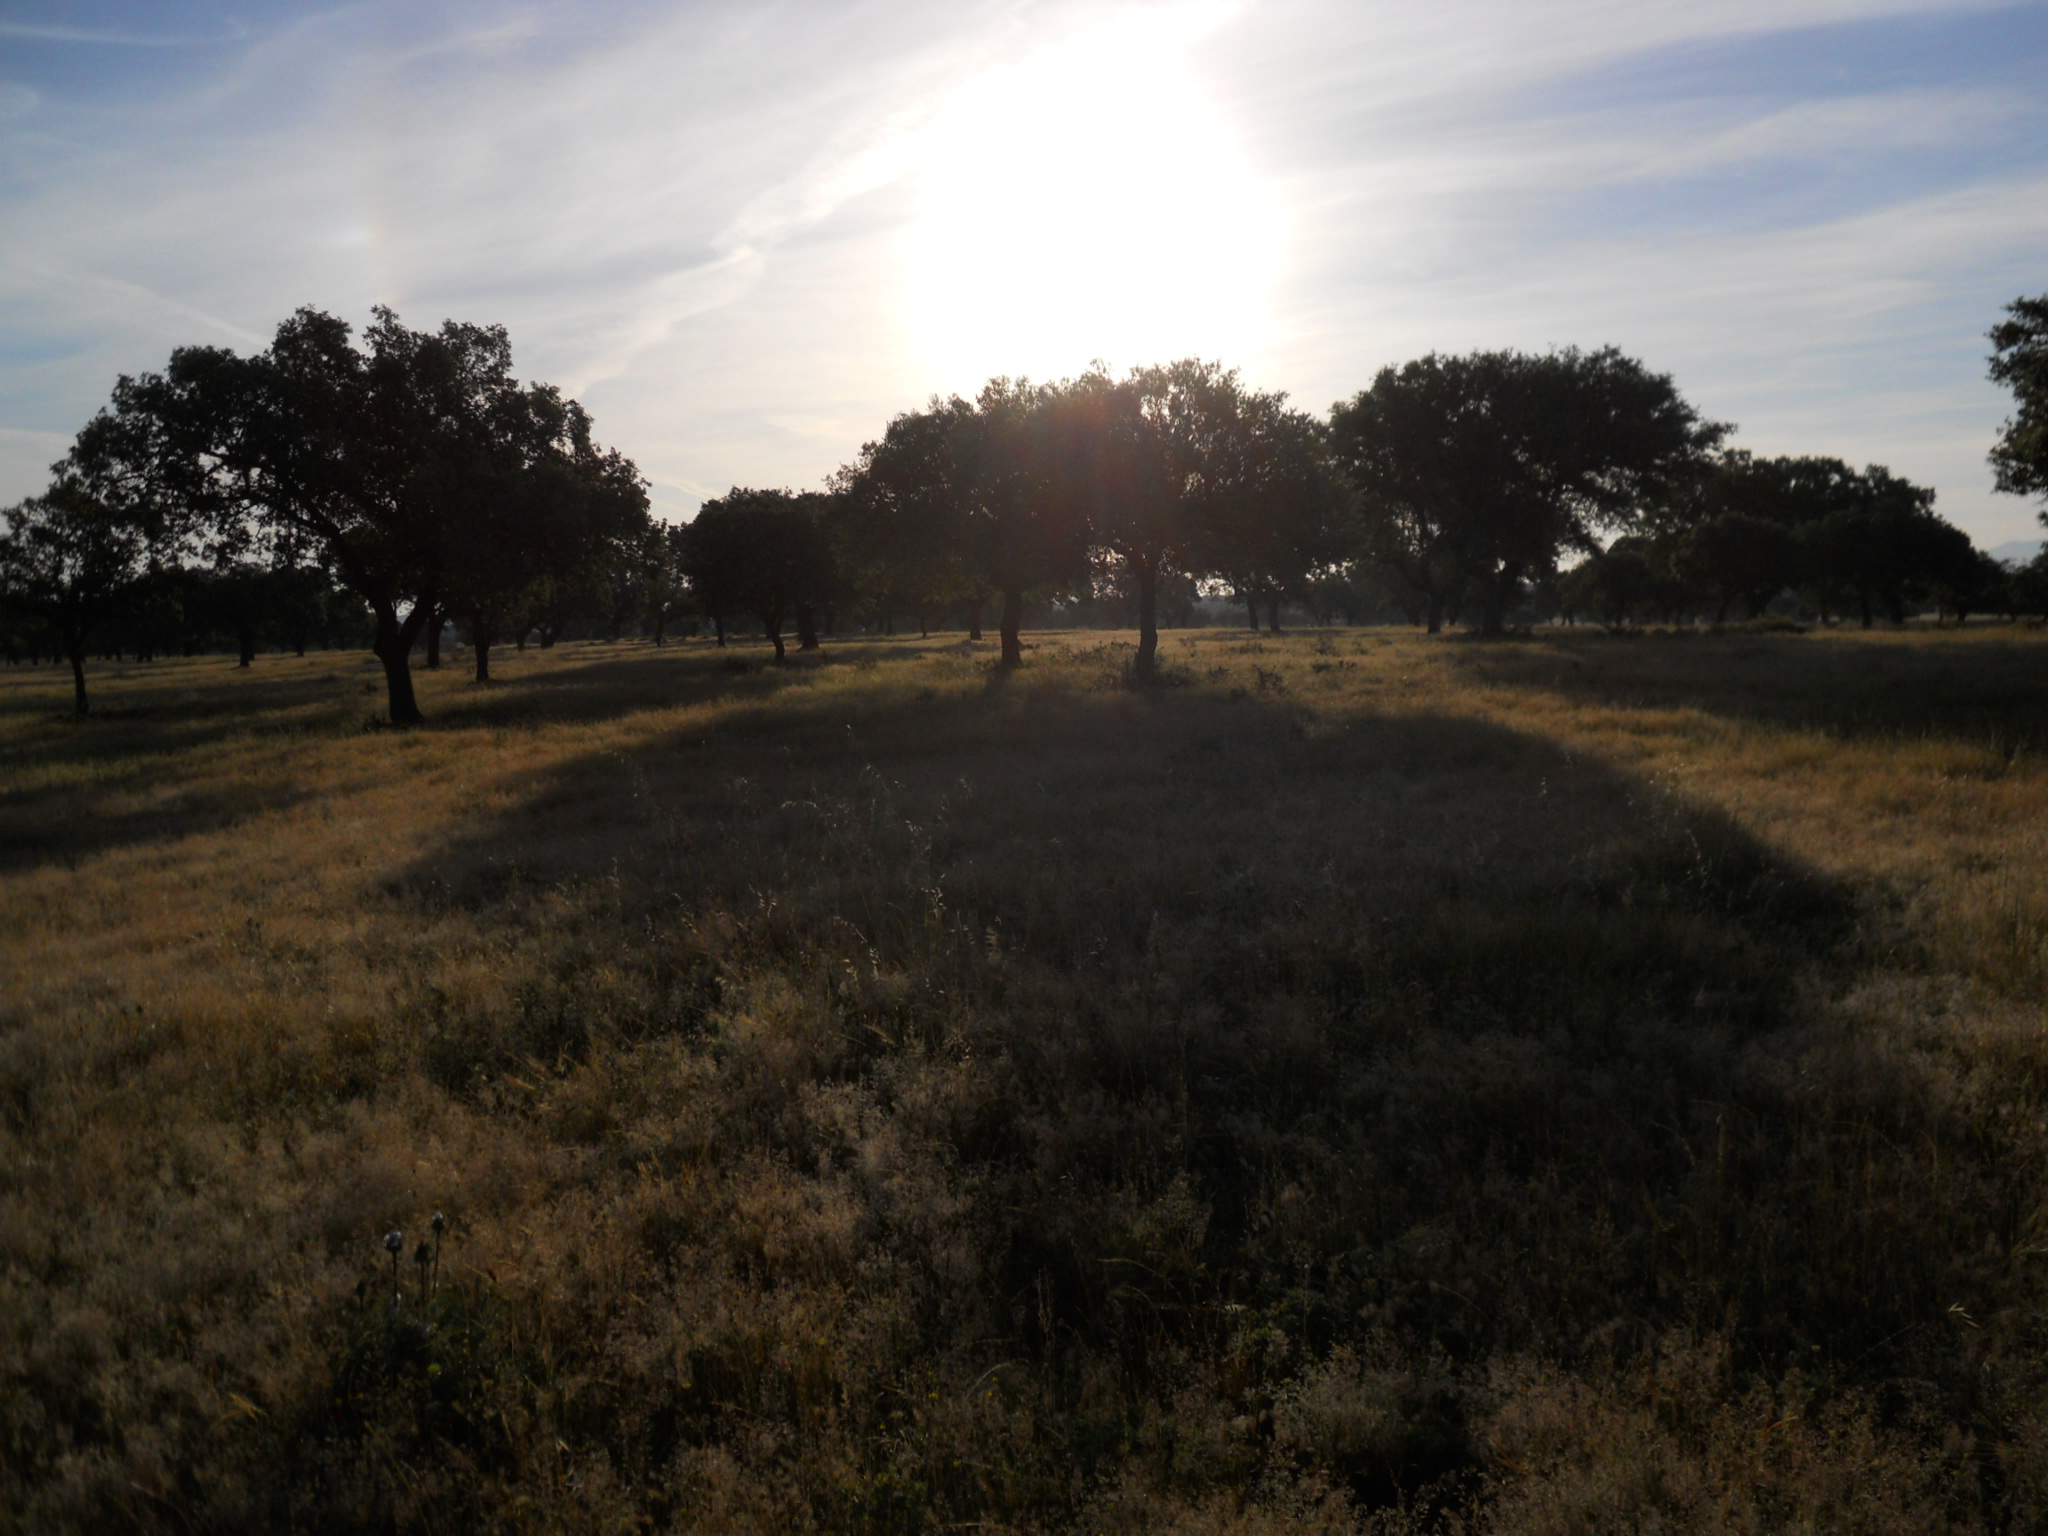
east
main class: Woodland
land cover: Broadleaved woodland
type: broadleaved evergreen forest
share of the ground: 10 - 25 %
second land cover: Grassland without tree/shrub cover
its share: > 75 %
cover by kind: herbaceous plants 80 %, broadleaved forest trees 20 %
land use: Forestry
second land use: Agriculture (excluding fallow land and kitchen gardens)
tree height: > 5 m
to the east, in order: Broadleaved woodland; Grassland without tree/shrub cover; Rock outcrops
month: May
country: ES
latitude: 39.2682
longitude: -6.3723
